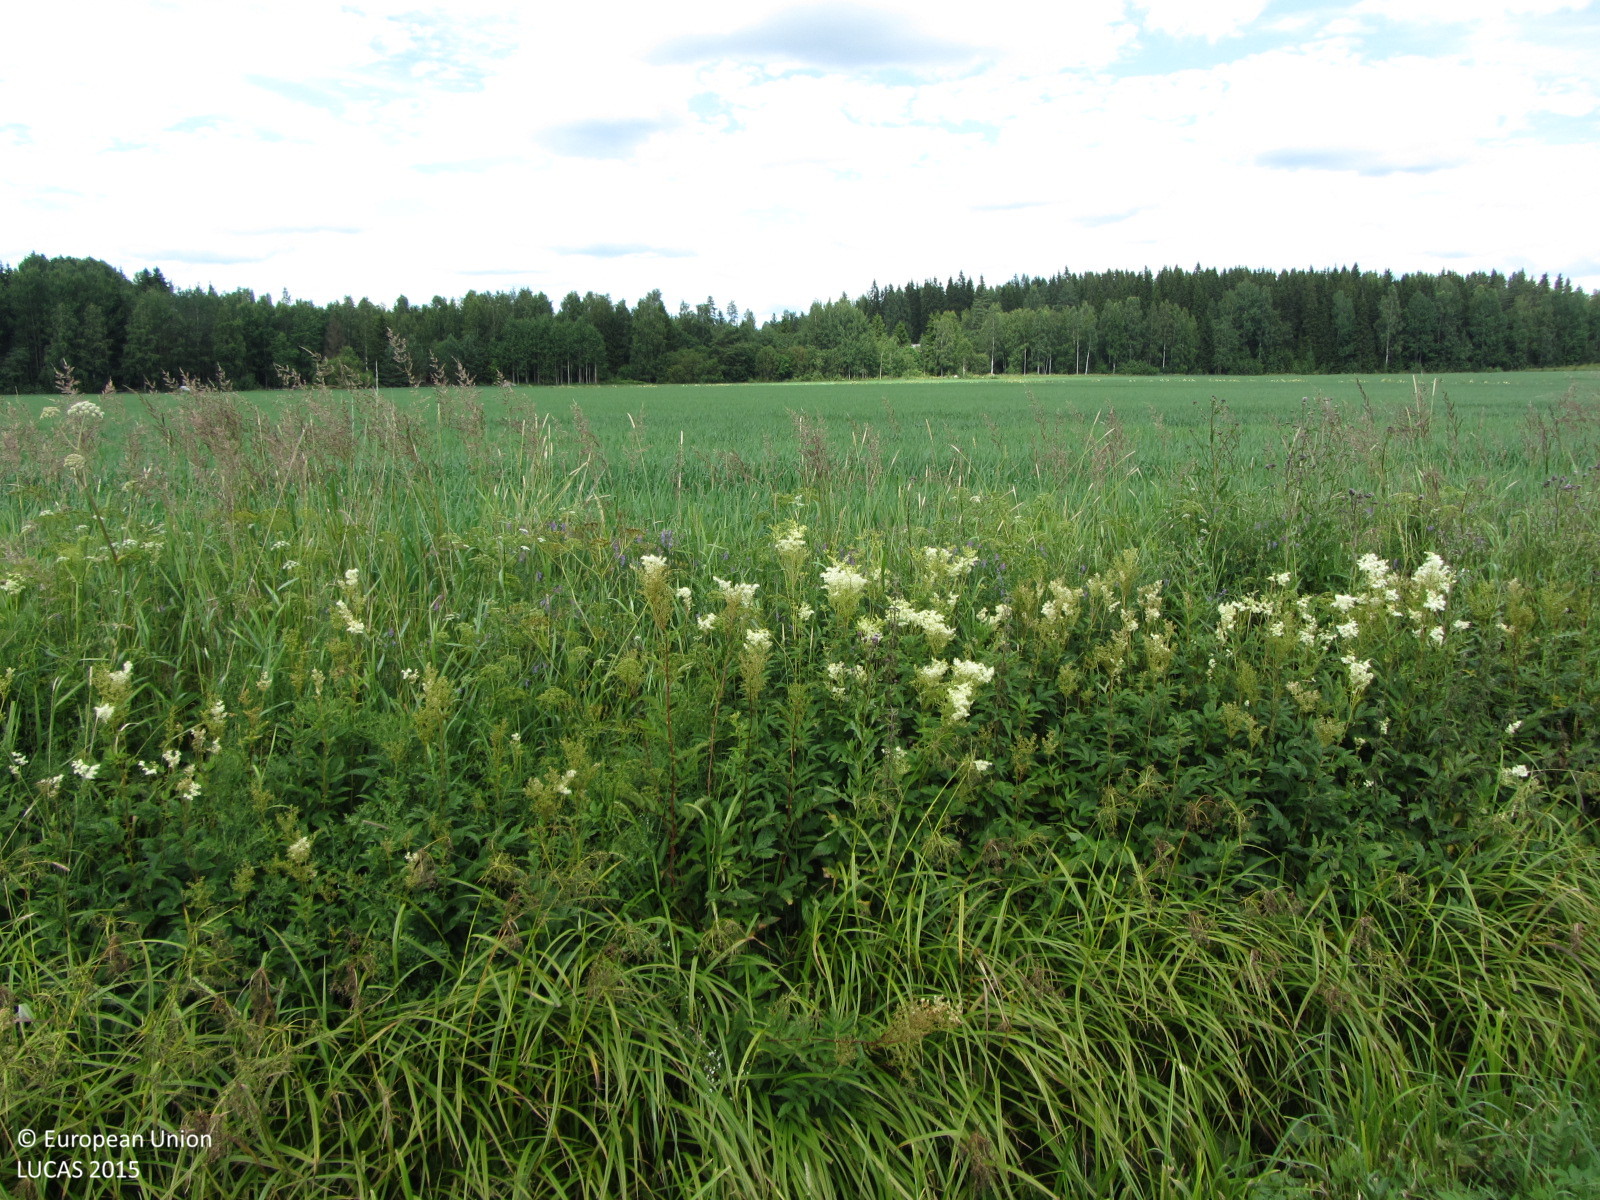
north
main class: Grassland
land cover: Grassland without tree/shrub cover
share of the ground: > 75 %
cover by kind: herbaceous plants 100 %
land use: Agriculture (excluding fallow land and kitchen gardens)
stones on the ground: < 10 %
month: July
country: FI
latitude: 60.7080
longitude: 24.5255
